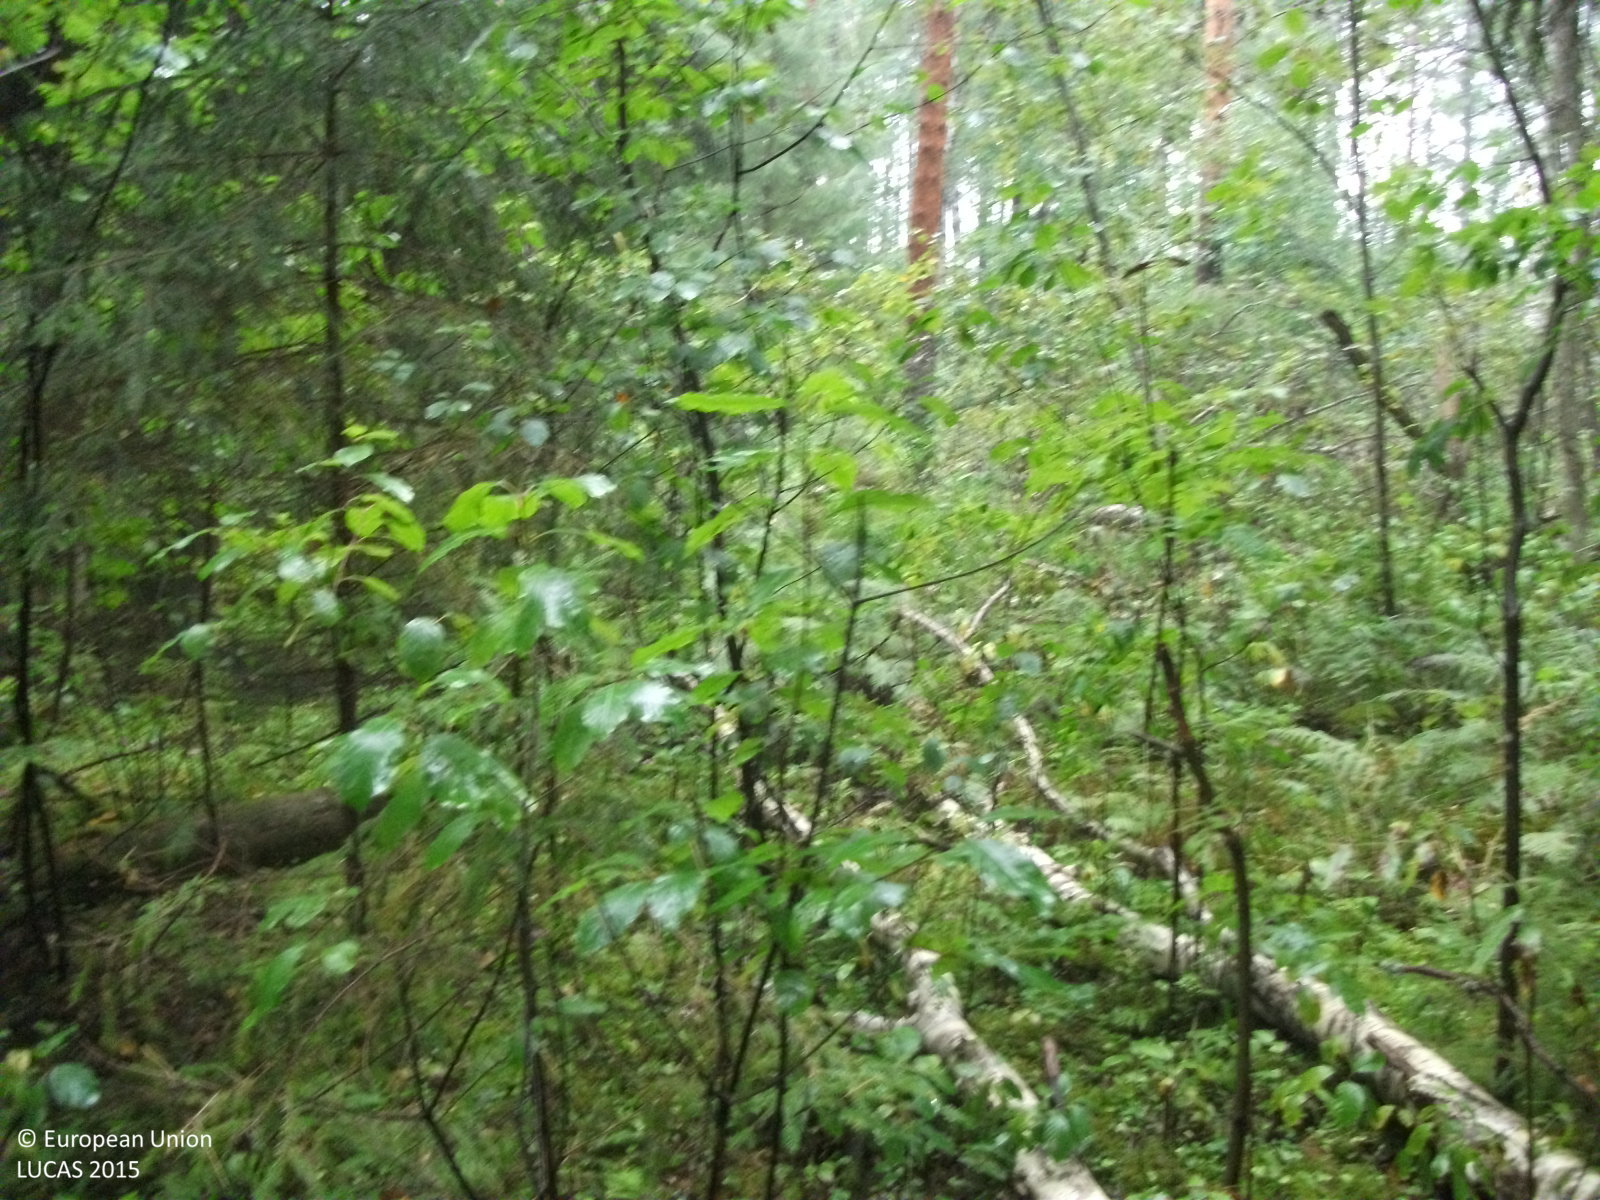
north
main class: Woodland
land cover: Spruce dominated mixed woodland
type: hemiboreal forest and nemoral coniferous forest and mixed broadleaved-coniferous forest
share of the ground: > 75 %
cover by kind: coniferous forest trees 55 %, broadleaved forest trees 30 %, herbaceous plants 10 %, shrubs 5 %
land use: Forestry
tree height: > 5 m
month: September
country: LV
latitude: 56.5975
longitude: 26.0804
